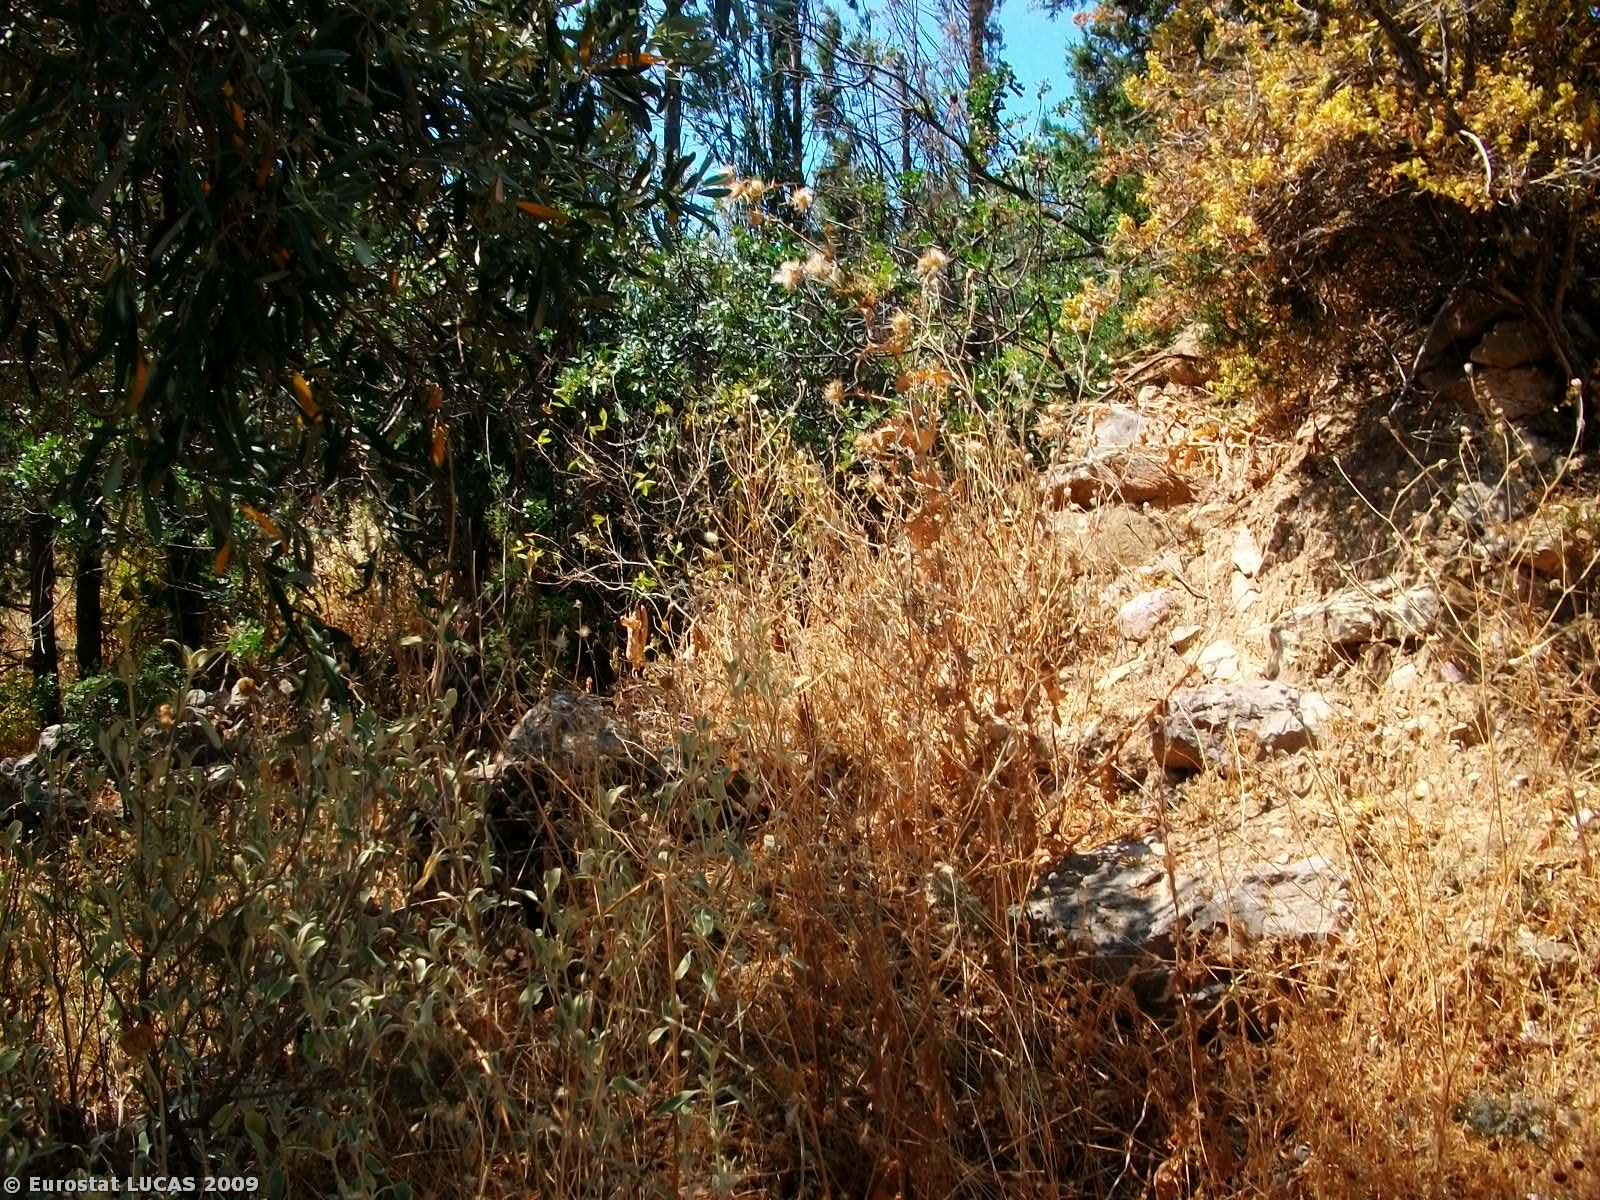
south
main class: Shrubland
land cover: Shrubland with sparse tree cover
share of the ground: 50 - 75 %
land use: Unused
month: July
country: GR
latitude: 38.3655
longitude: 22.3683
